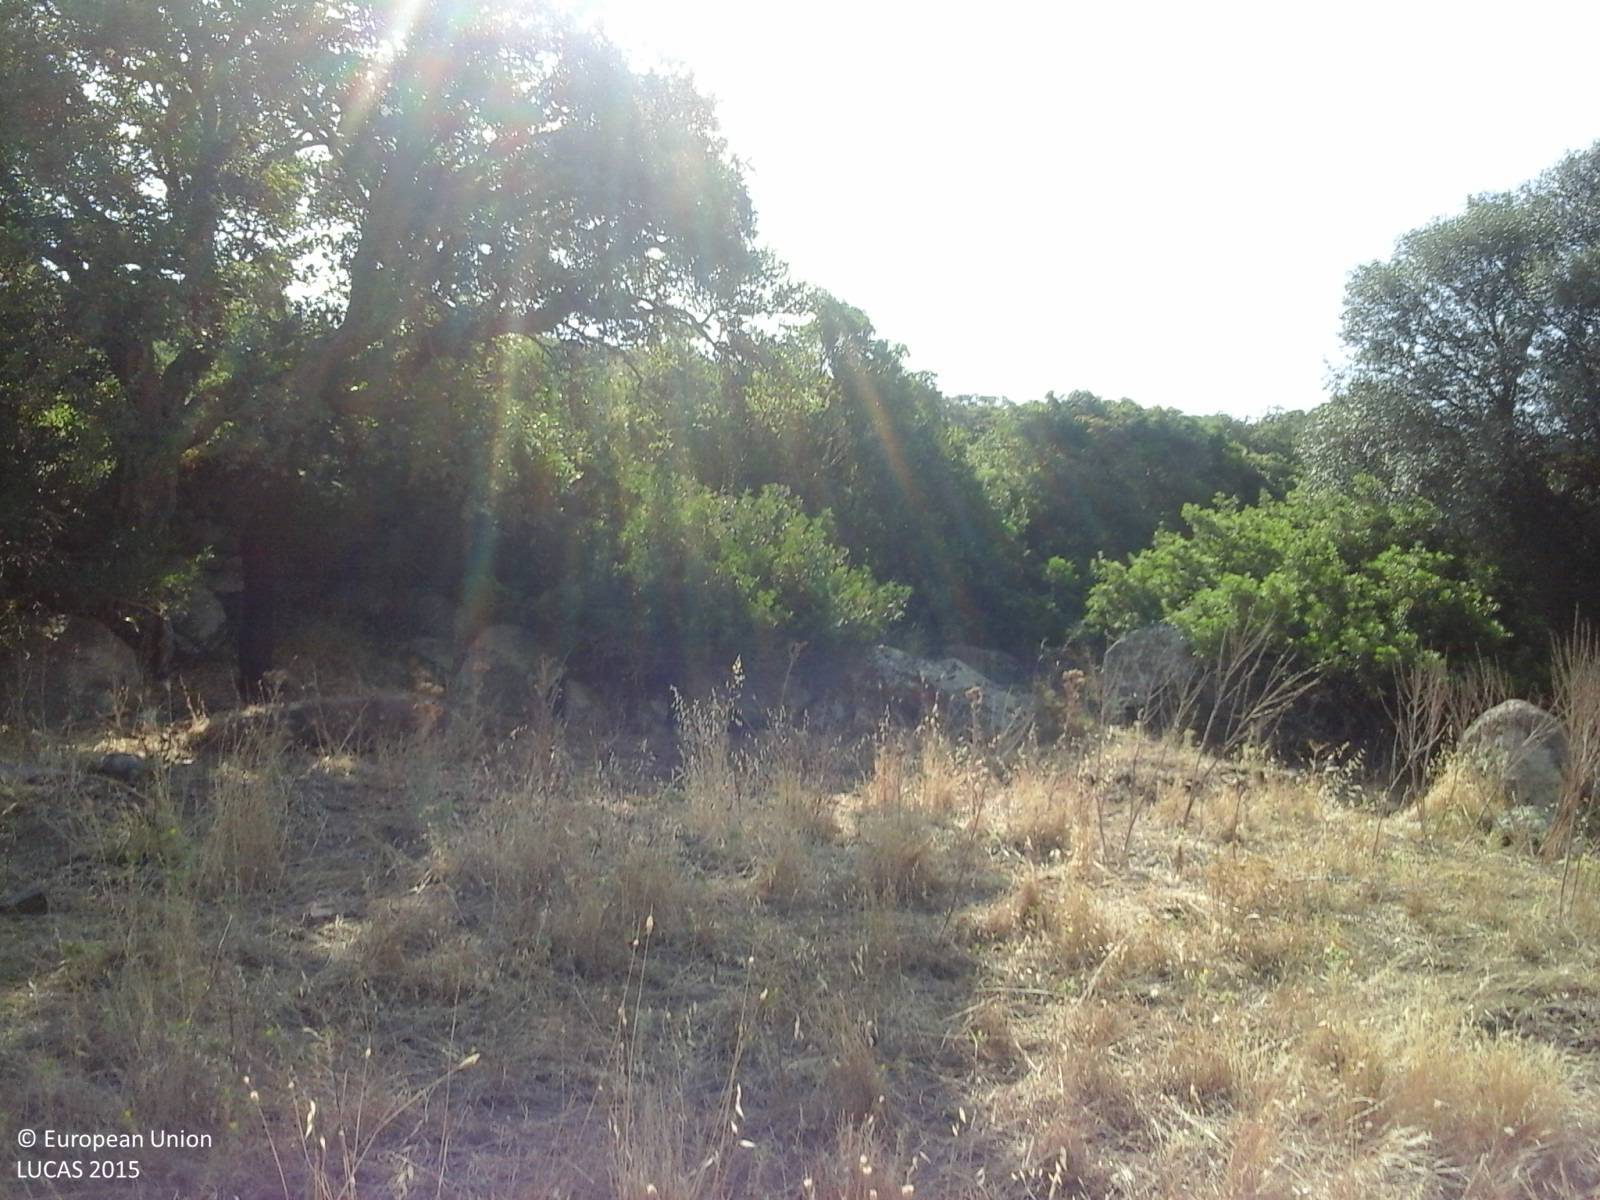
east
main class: Grassland
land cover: Grassland with sparse tree/shrub cover
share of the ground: > 75 %
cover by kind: herbaceous plants 85 %, shrubs 10 %, broadleaved forest trees 5 %
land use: Agriculture (excluding fallow land and kitchen gardens)
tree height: < 5 m
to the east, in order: Grassland with sparse tree/shrub cover; Broadleaved woodland; Dry stone walls; Broadleaved woodland; Dry stone walls; Grassland with sparse tree/shrub cover; Fences; Dry stone walls; Tracks; Dry stone walls; Fences; Grassland with sparse tree/shrub cover; Electric lines; Dry stone walls; Fences; Grassland with sparse tree/shrub cover
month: July
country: IT
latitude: 39.9171
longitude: 8.8947
